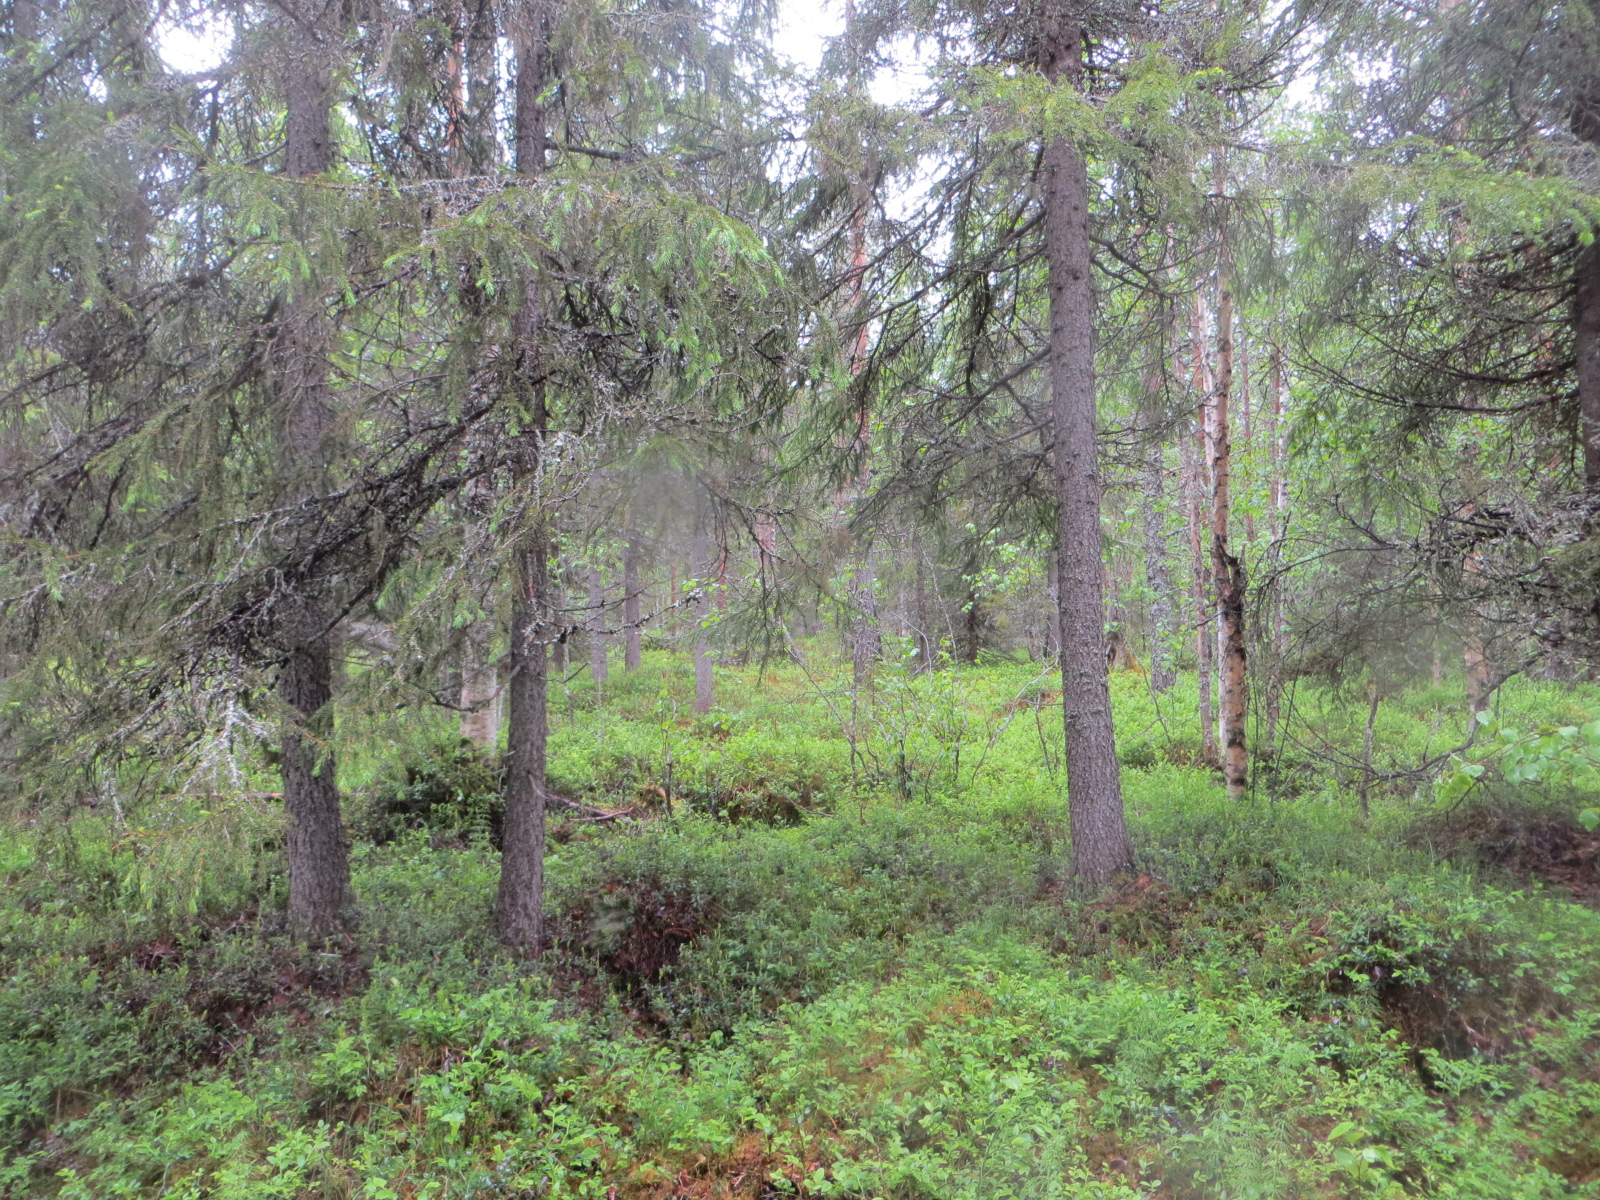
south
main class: Woodland
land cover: Other mixed woodland
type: boreal forest
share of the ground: > 75 %
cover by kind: coniferous forest trees 40 %, broadleaved forest trees 35 %, shrubs 25 %
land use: Forestry
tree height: > 5 m
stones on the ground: < 10 %
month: June
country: FI
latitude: 66.0597
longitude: 26.9563
